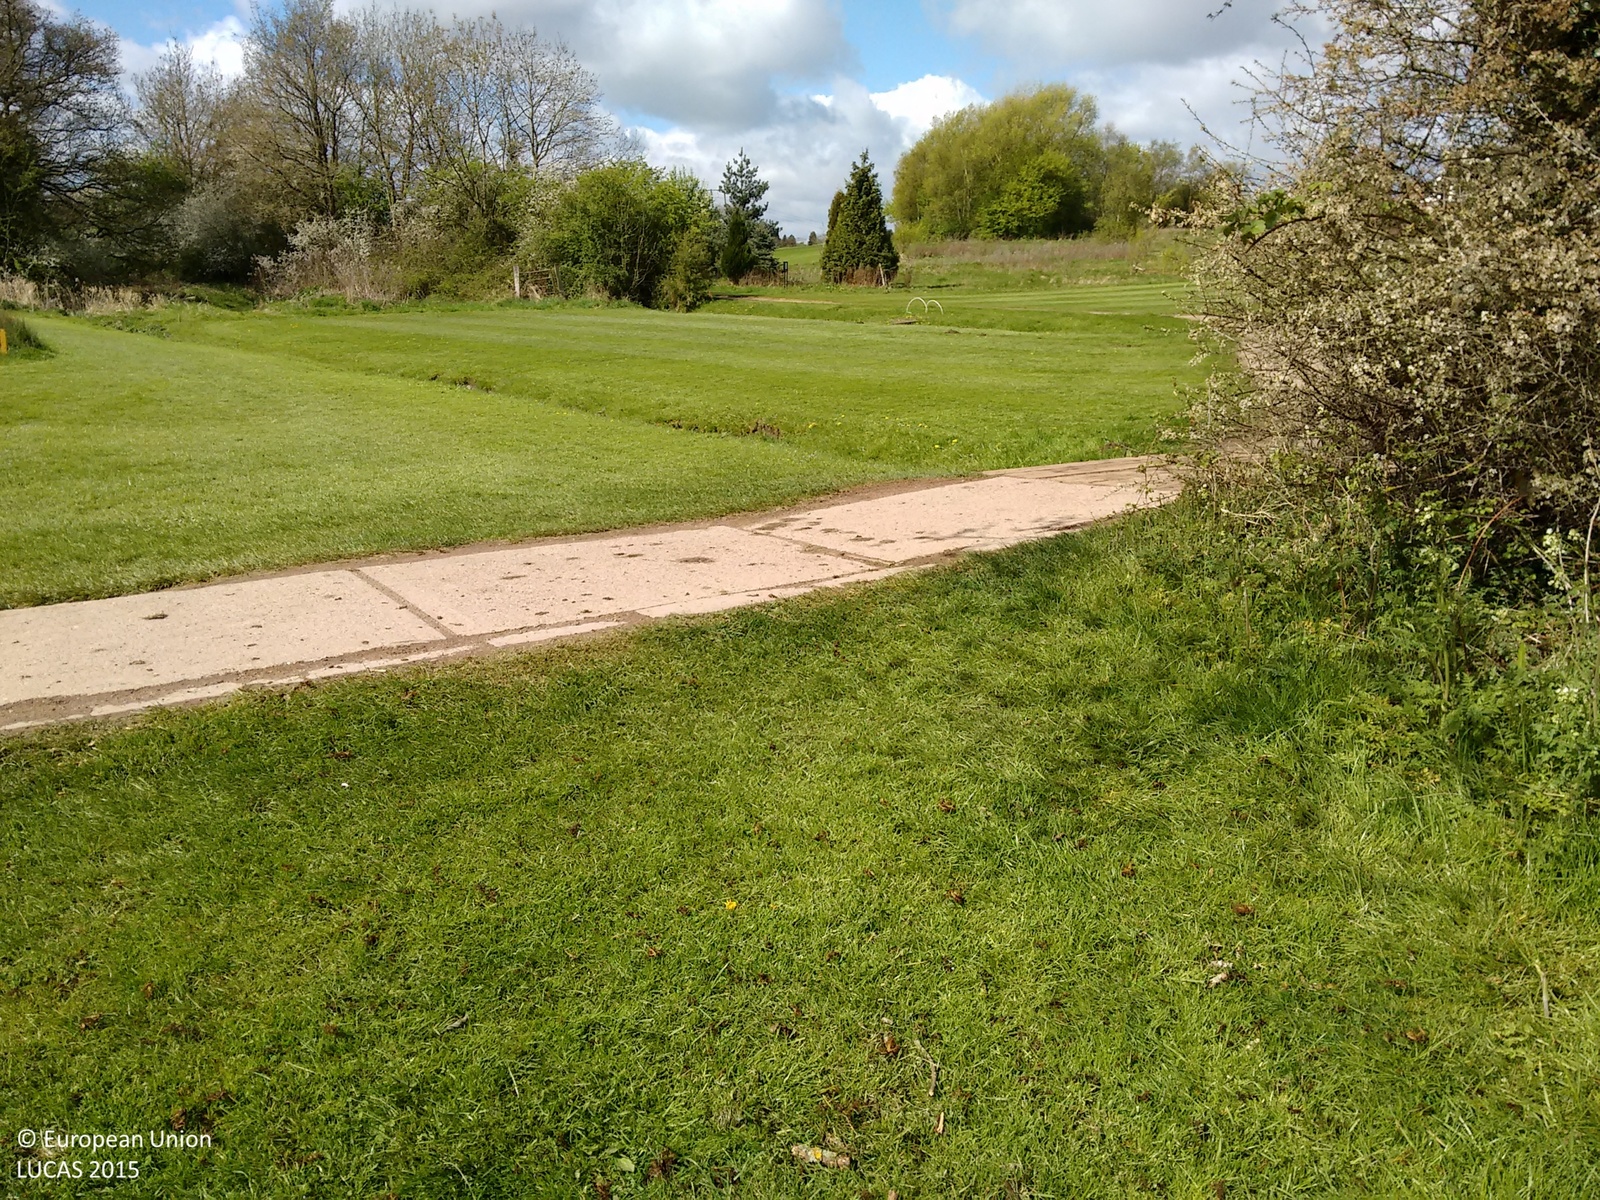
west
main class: Grassland
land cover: Grassland without tree/shrub cover
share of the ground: > 75 %
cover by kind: herbaceous plants 100 %
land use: Semi-natural and natural areas not in use
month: April
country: GB
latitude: 52.3191
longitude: -1.9257
